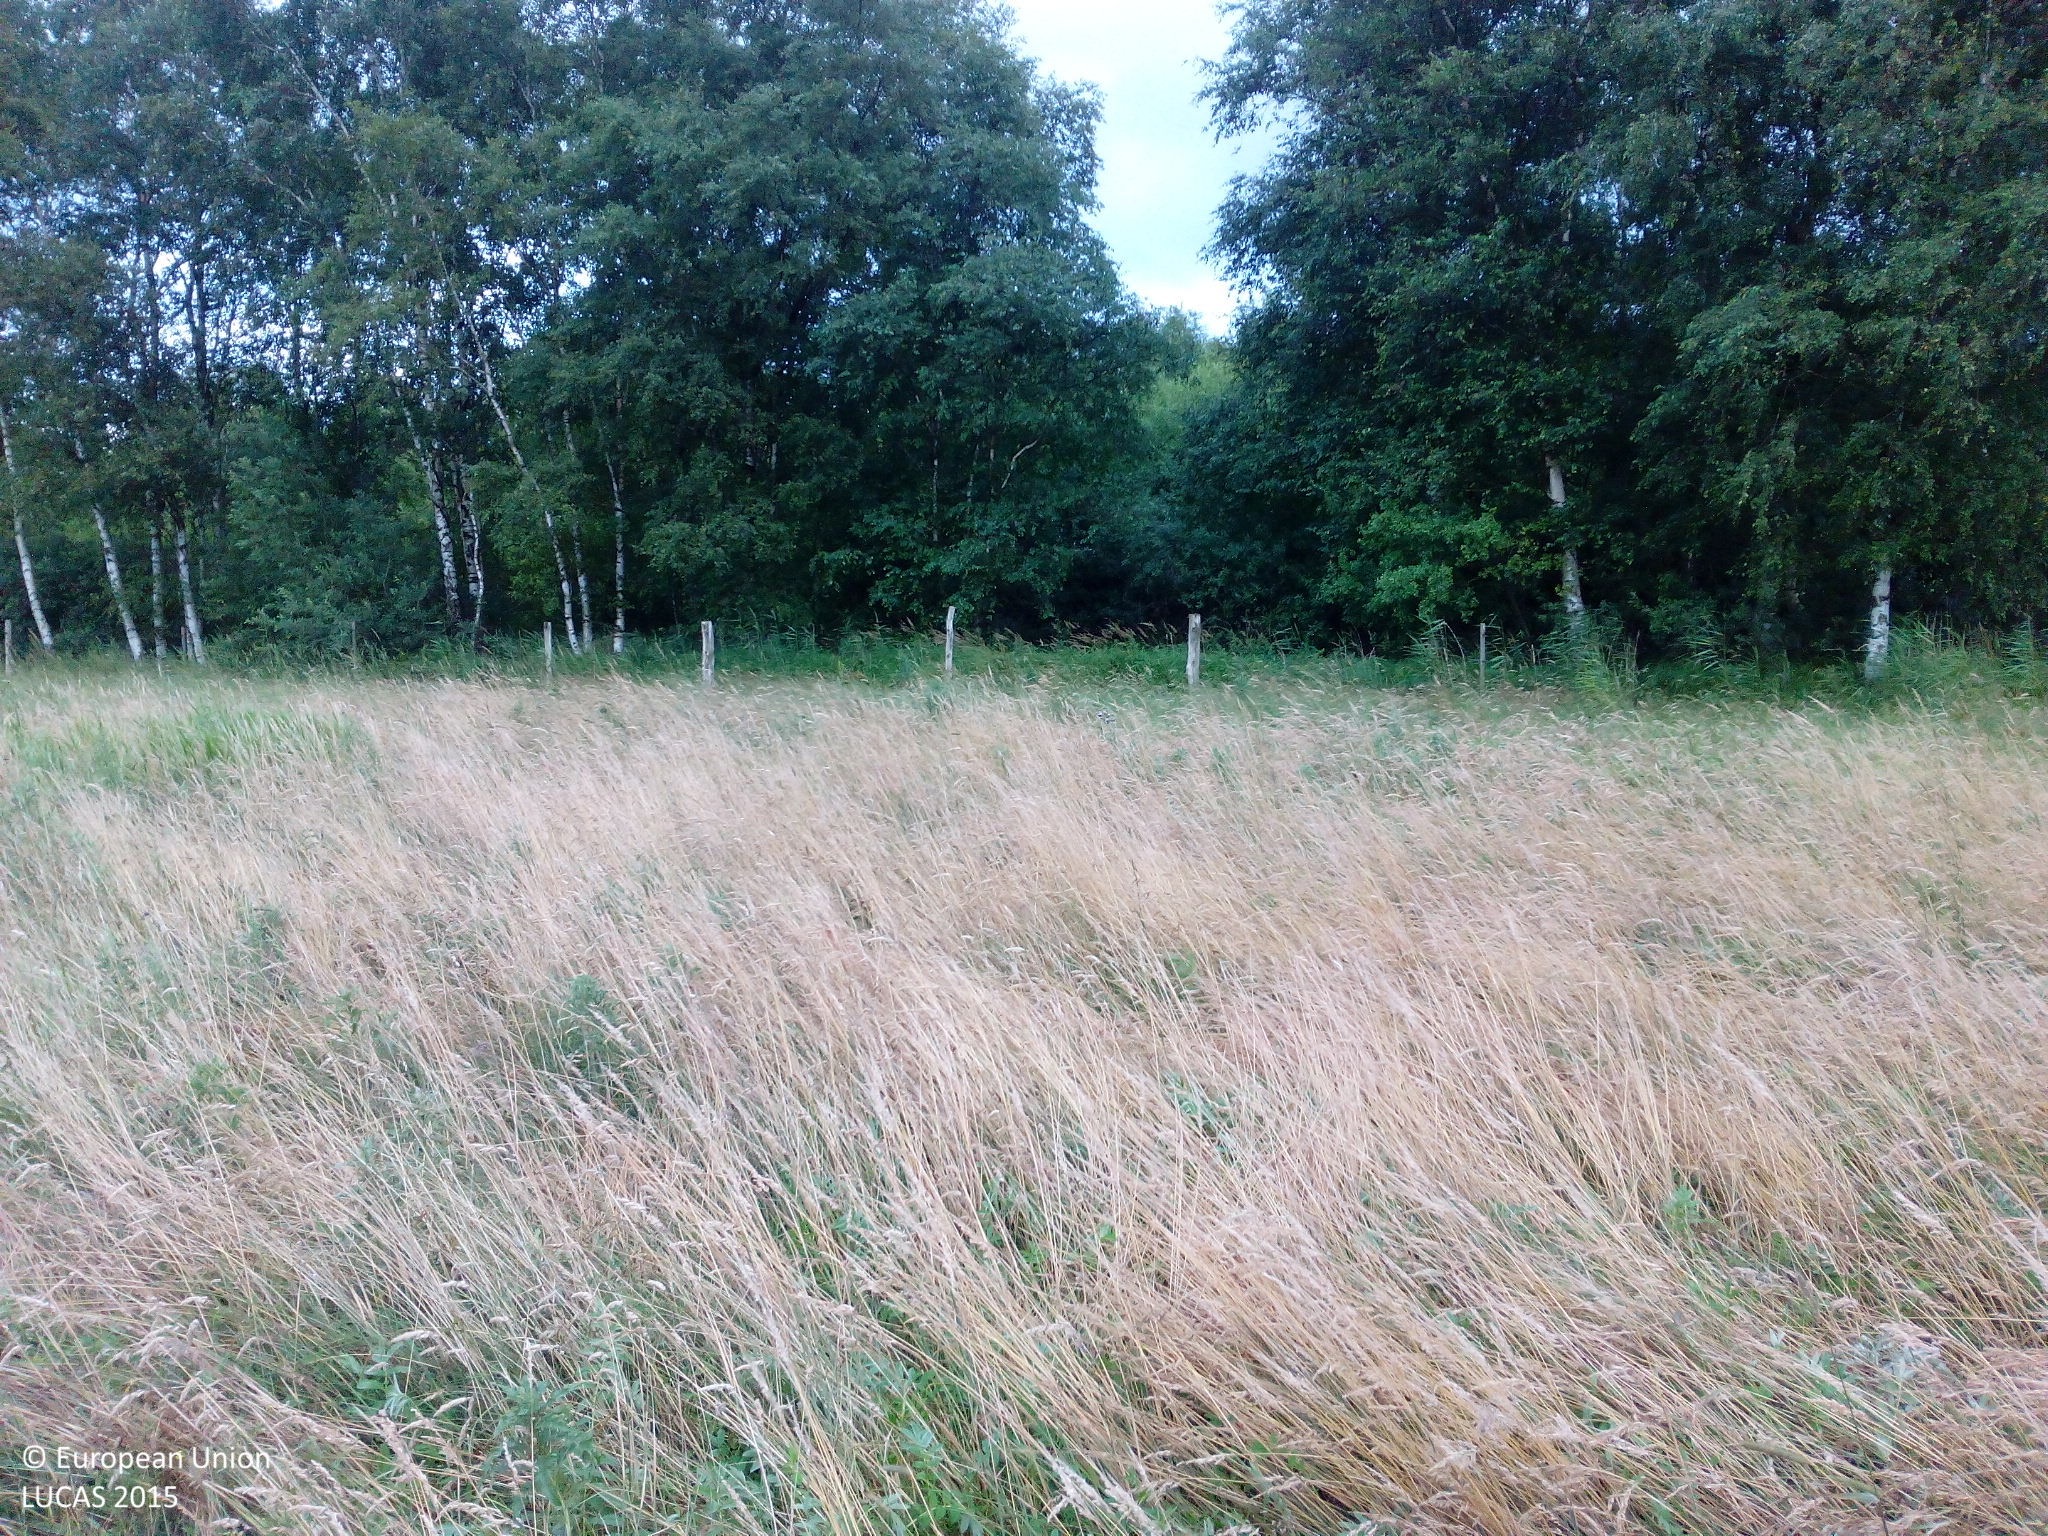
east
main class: Grassland
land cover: Grassland without tree/shrub cover
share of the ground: > 75 %
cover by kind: herbaceous plants 100 %
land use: Agriculture (excluding fallow land and kitchen gardens)
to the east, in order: Grassland without tree/shrub cover; Fences; Broadleaved woodland; Inland marshes; Broadleaved woodland
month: July
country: DK
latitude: 55.8792
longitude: 12.3157
